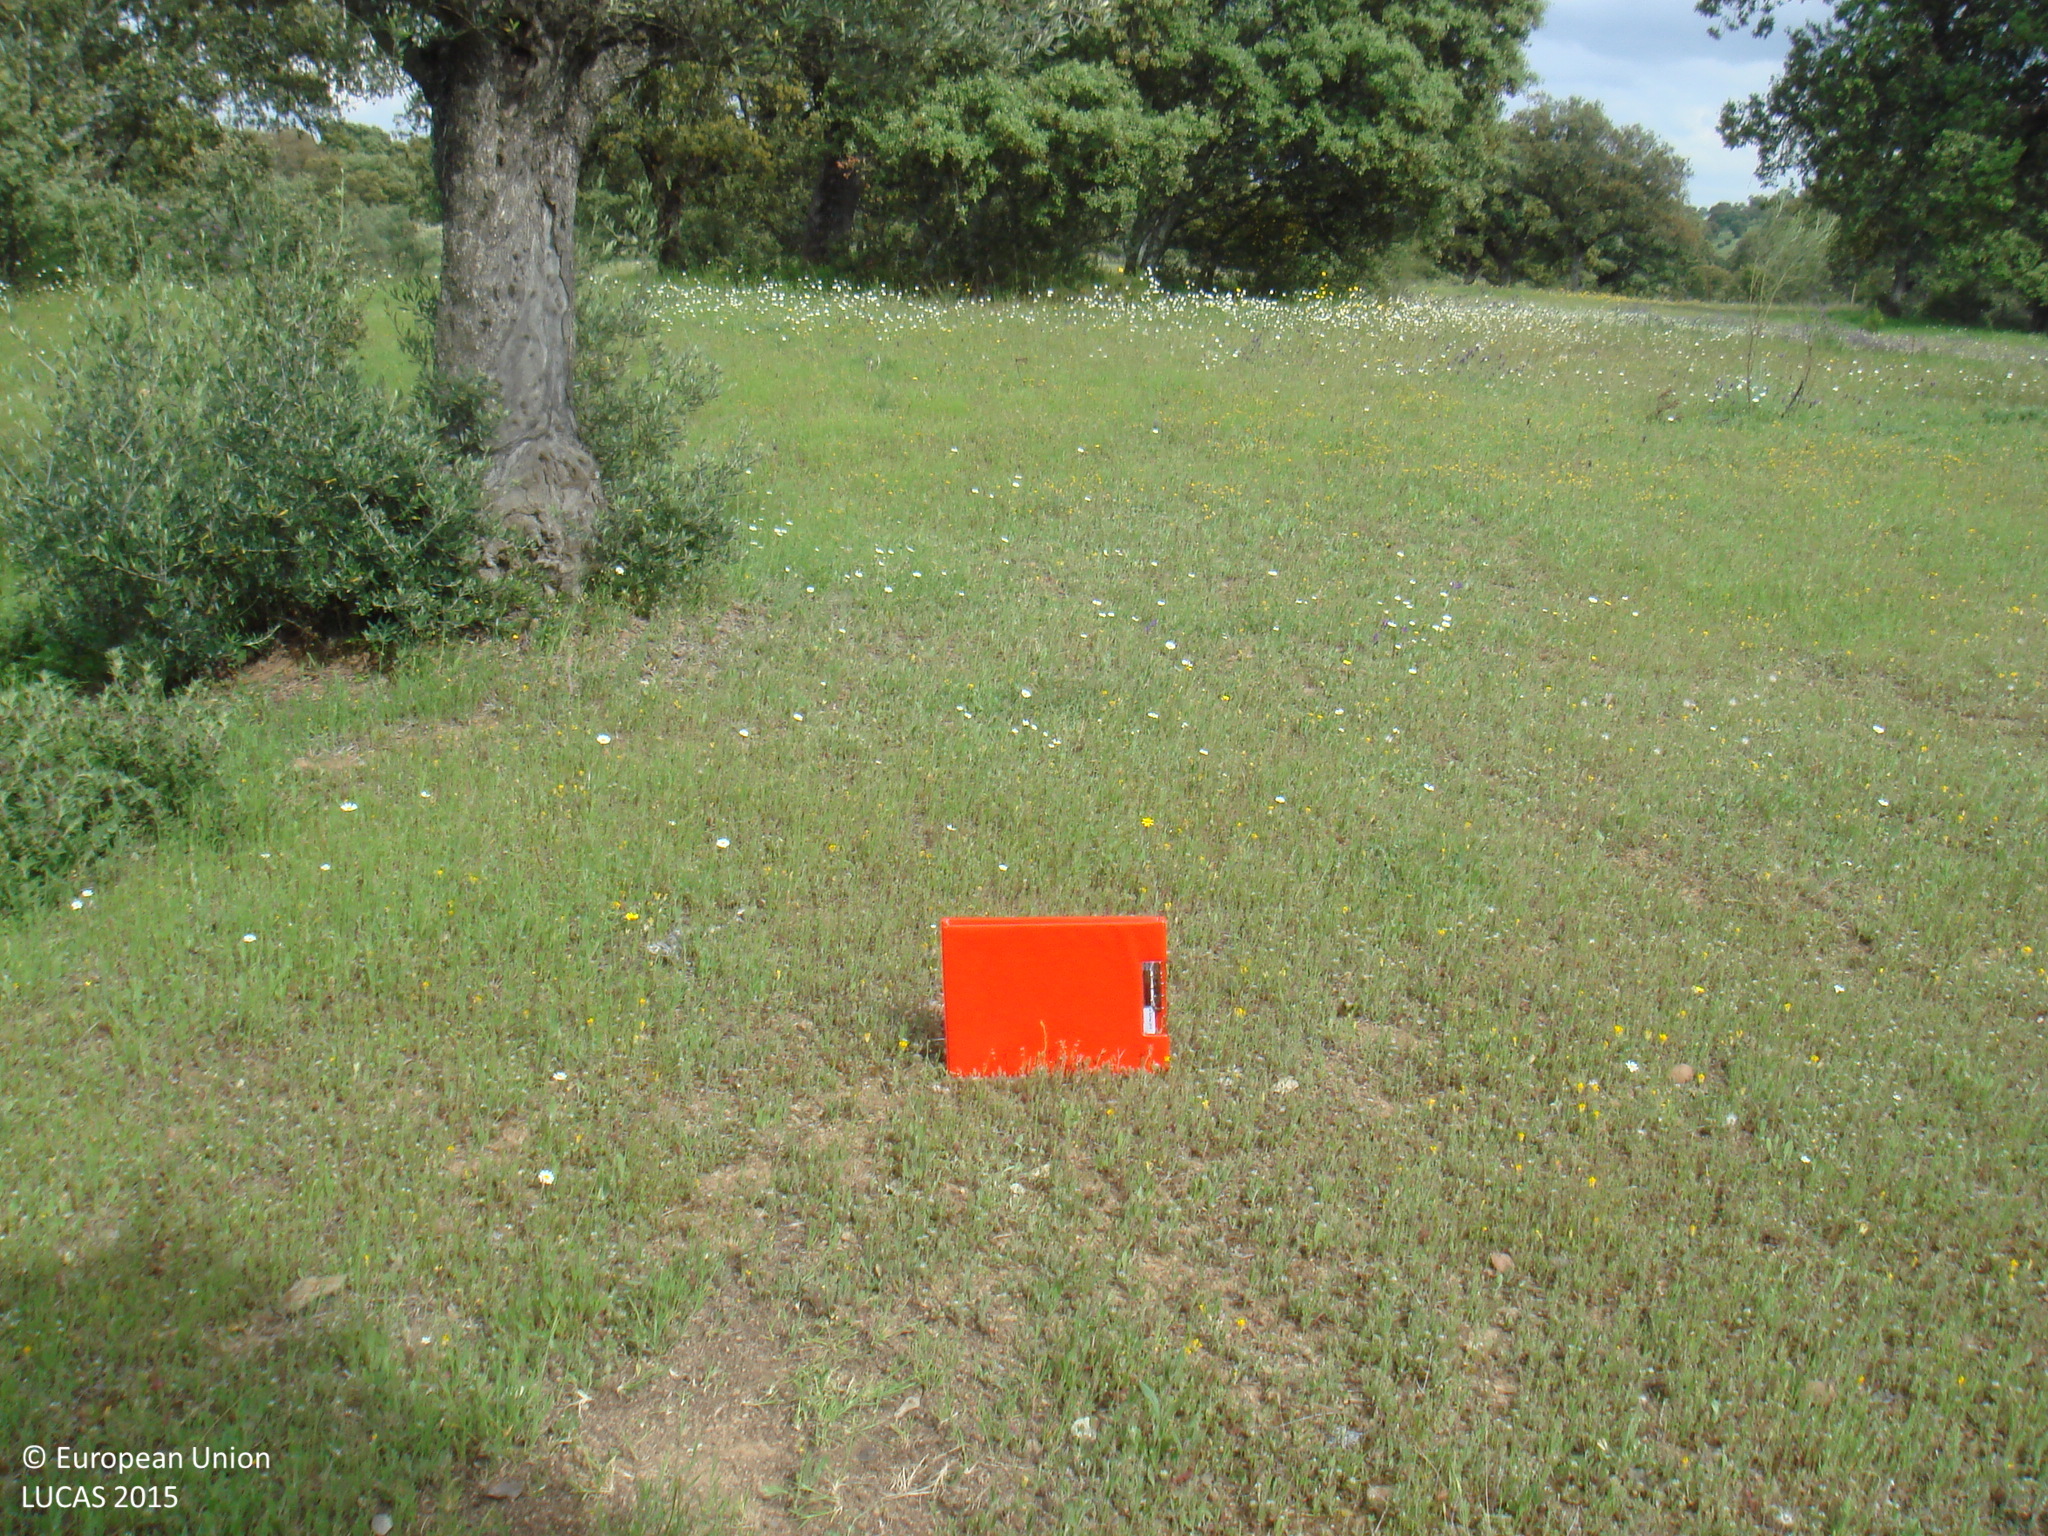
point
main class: Cropland
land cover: Olive groves
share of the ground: 10 - 25 %
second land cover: Grassland without tree/shrub cover
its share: > 75 %
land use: Agriculture (excluding fallow land and kitchen gardens)
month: April
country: ES
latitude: 38.2036
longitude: -5.0170
